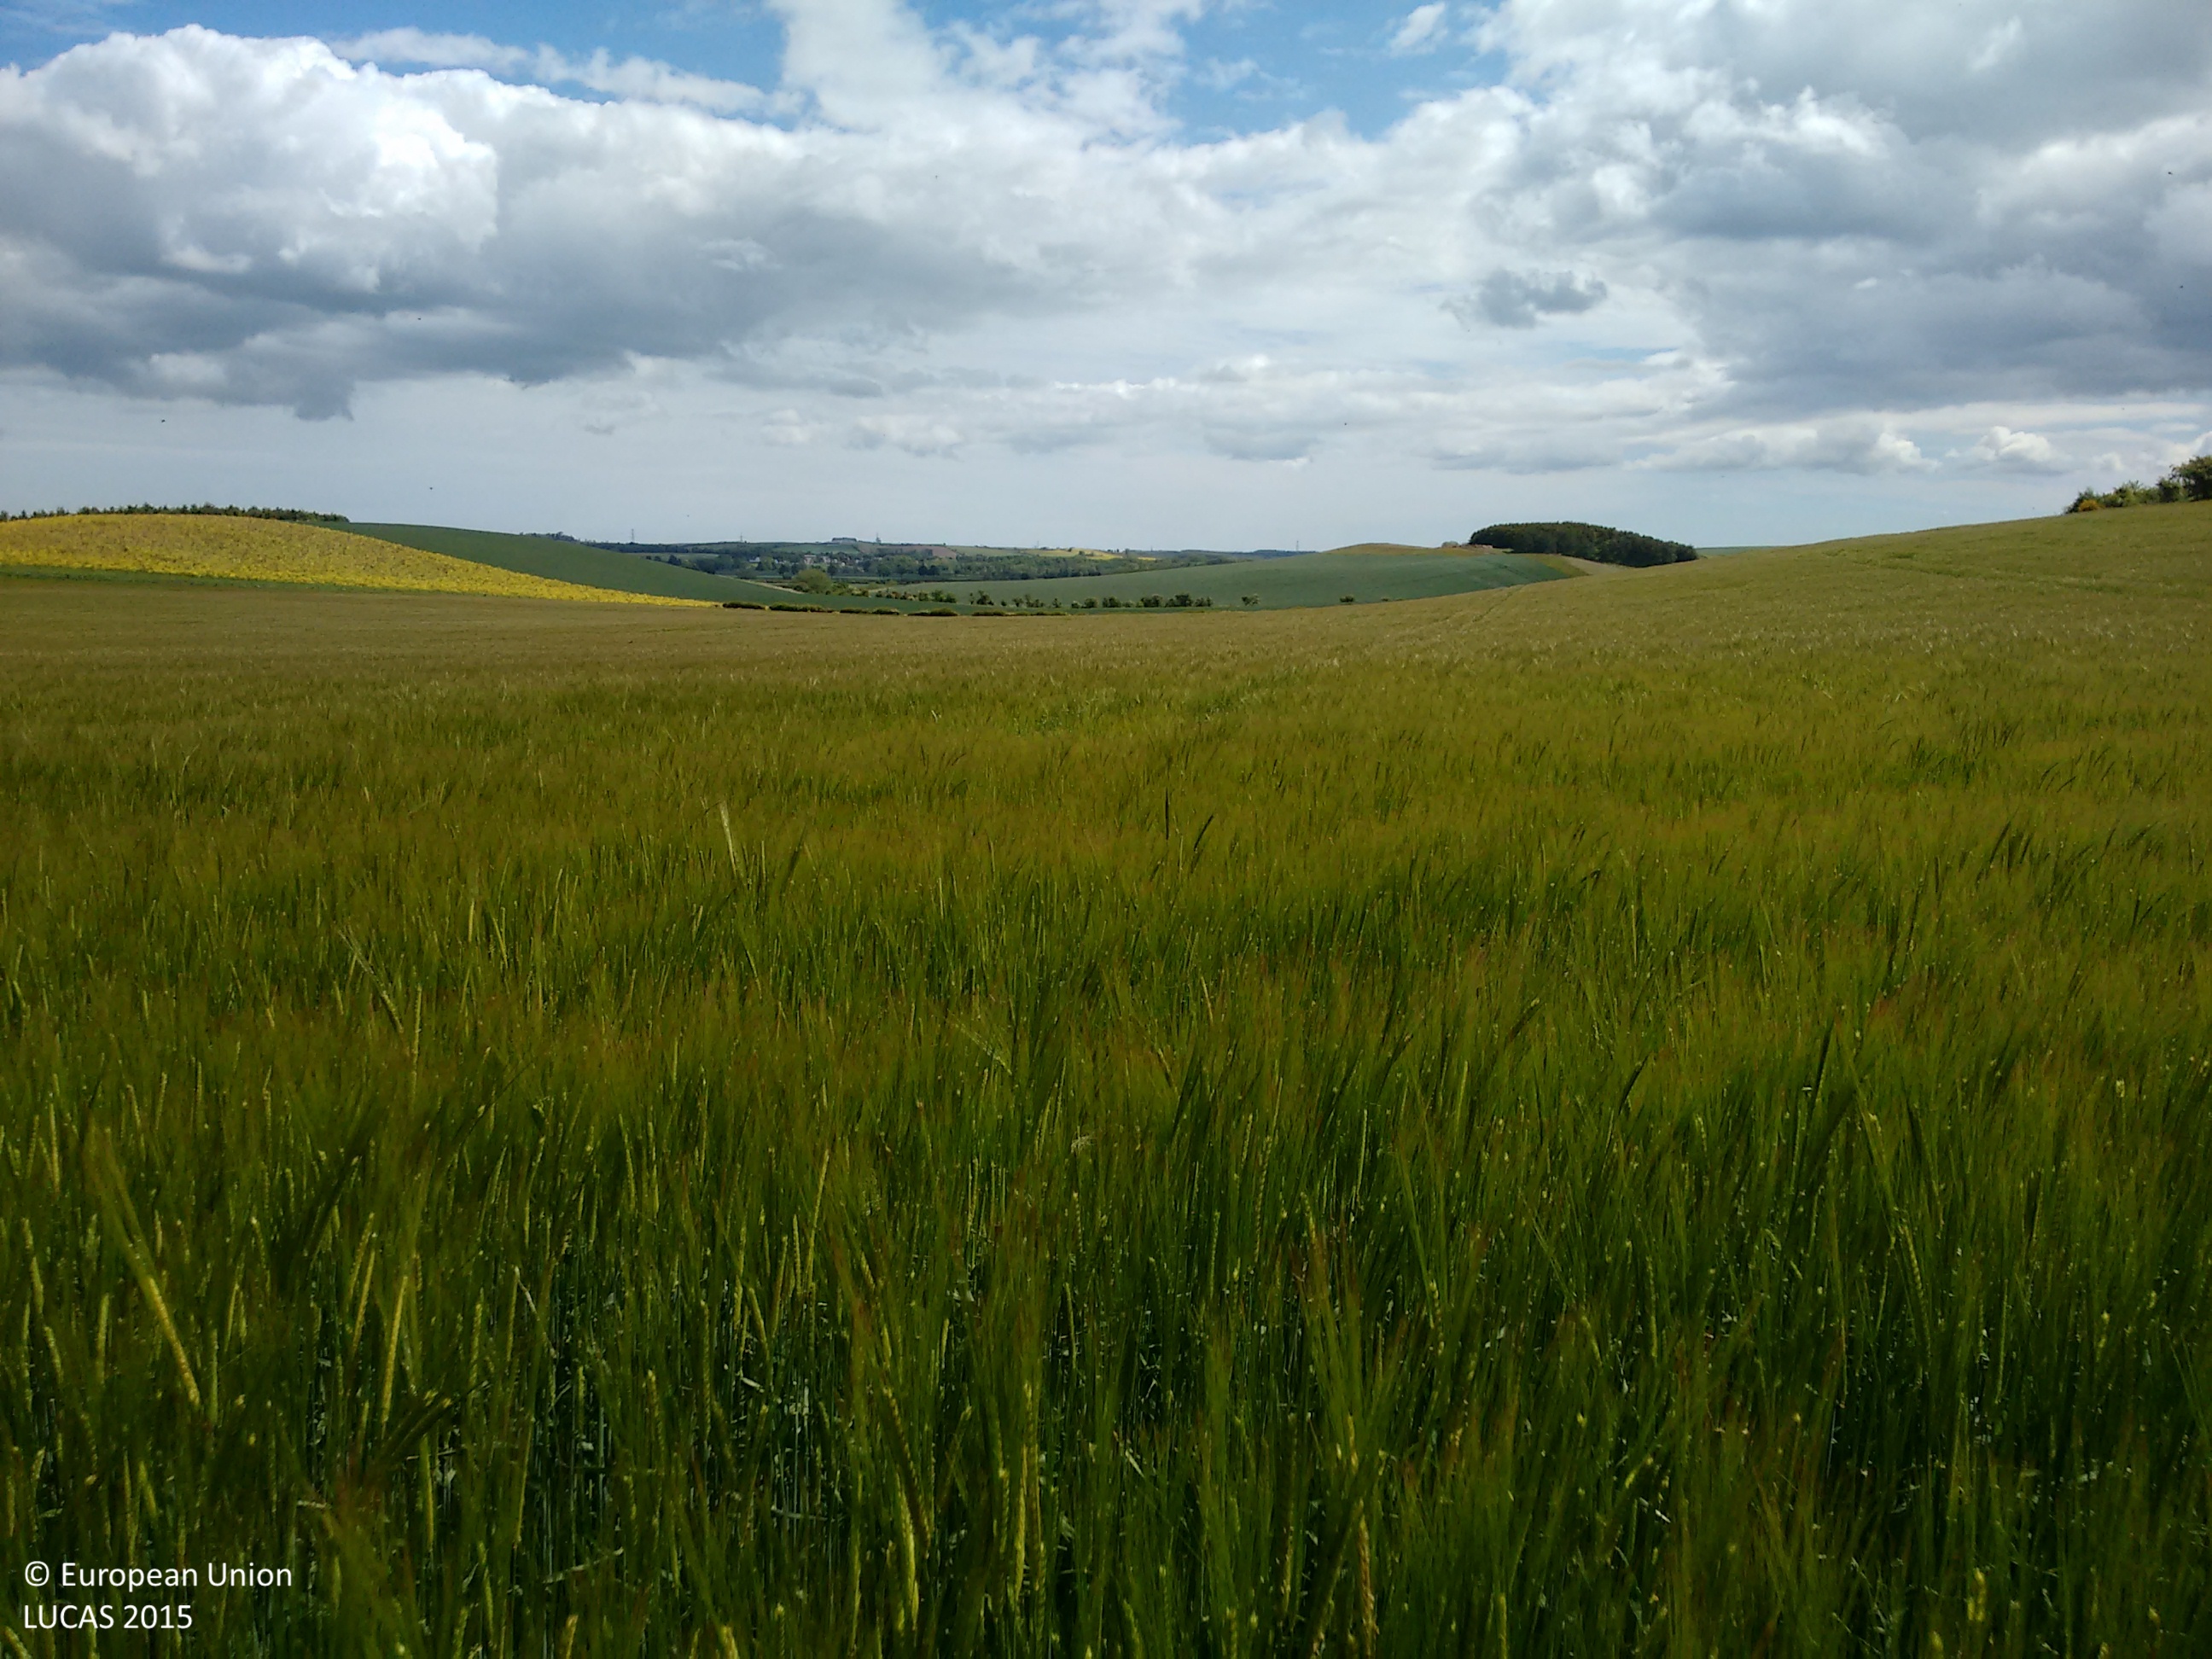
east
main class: Cropland
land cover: Barley
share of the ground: > 75 %
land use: Agriculture (excluding fallow land and kitchen gardens)
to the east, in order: Barley
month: June
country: GB
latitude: 55.6324
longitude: -2.2717
